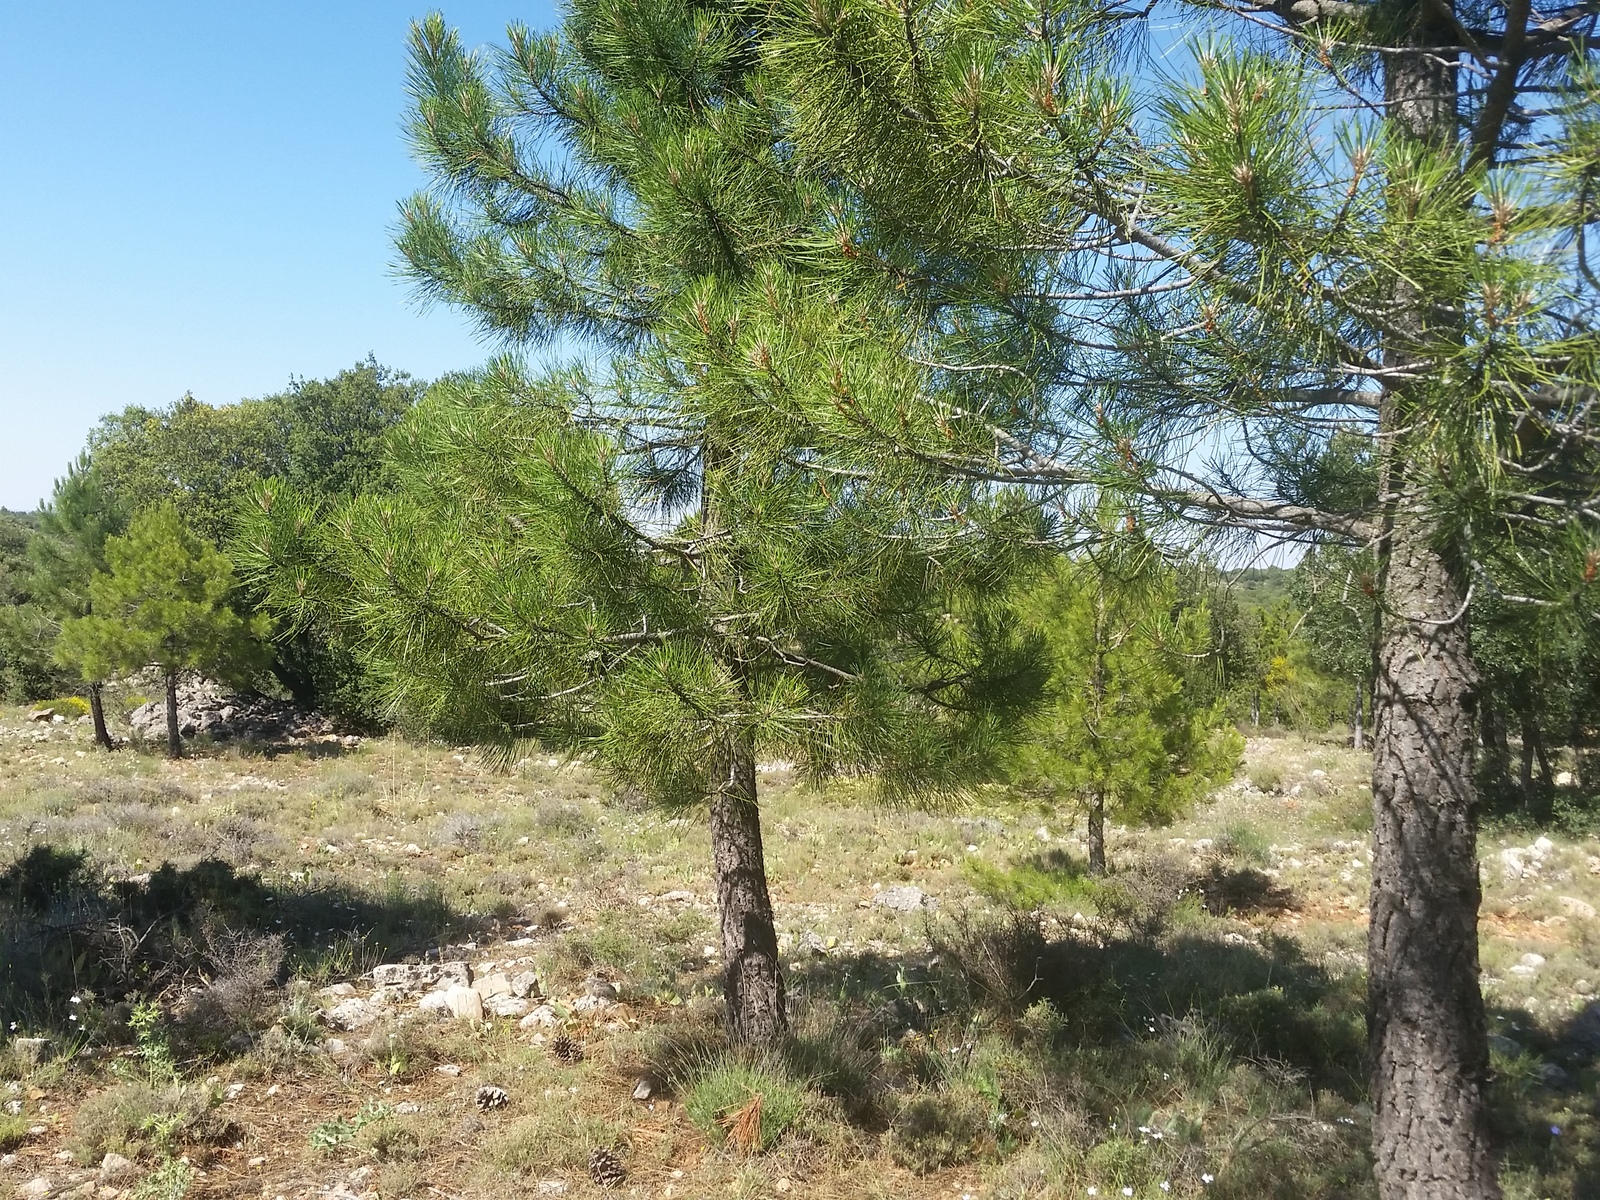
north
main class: Woodland
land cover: Pine dominated mixed woodland
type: coniferous forest of the mediterranean region
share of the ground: > 75 %
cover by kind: shrubs 30 %, coniferous forest trees 25 %, broadleaved forest trees 25 %, consolidated bare surface 15 %, herbaceous plants 5 %
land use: Forestry
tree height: > 5 m
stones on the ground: 10 - 25 %
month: June
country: ES
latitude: 38.5771
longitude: -2.5698
